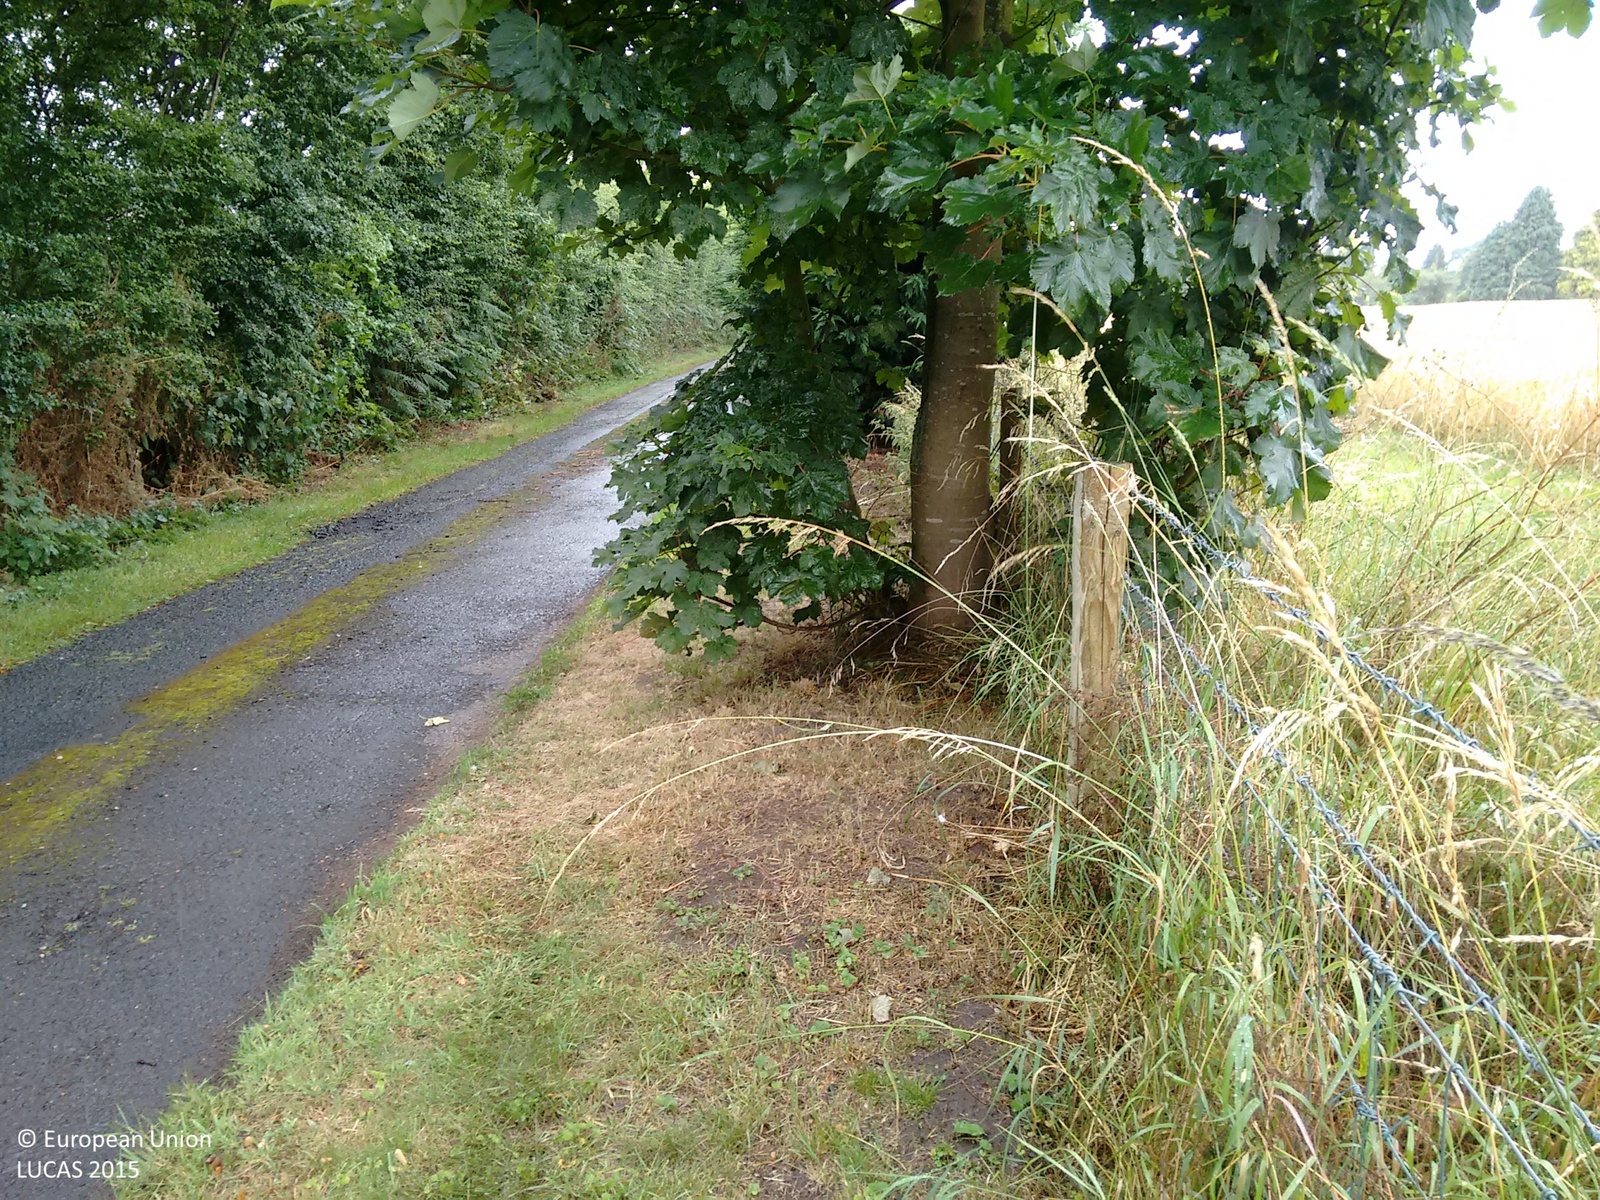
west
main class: Cropland
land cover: Barley
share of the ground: > 75 %
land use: Agriculture (excluding fallow land and kitchen gardens)
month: July
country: GB
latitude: 52.5223
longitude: -2.2507
